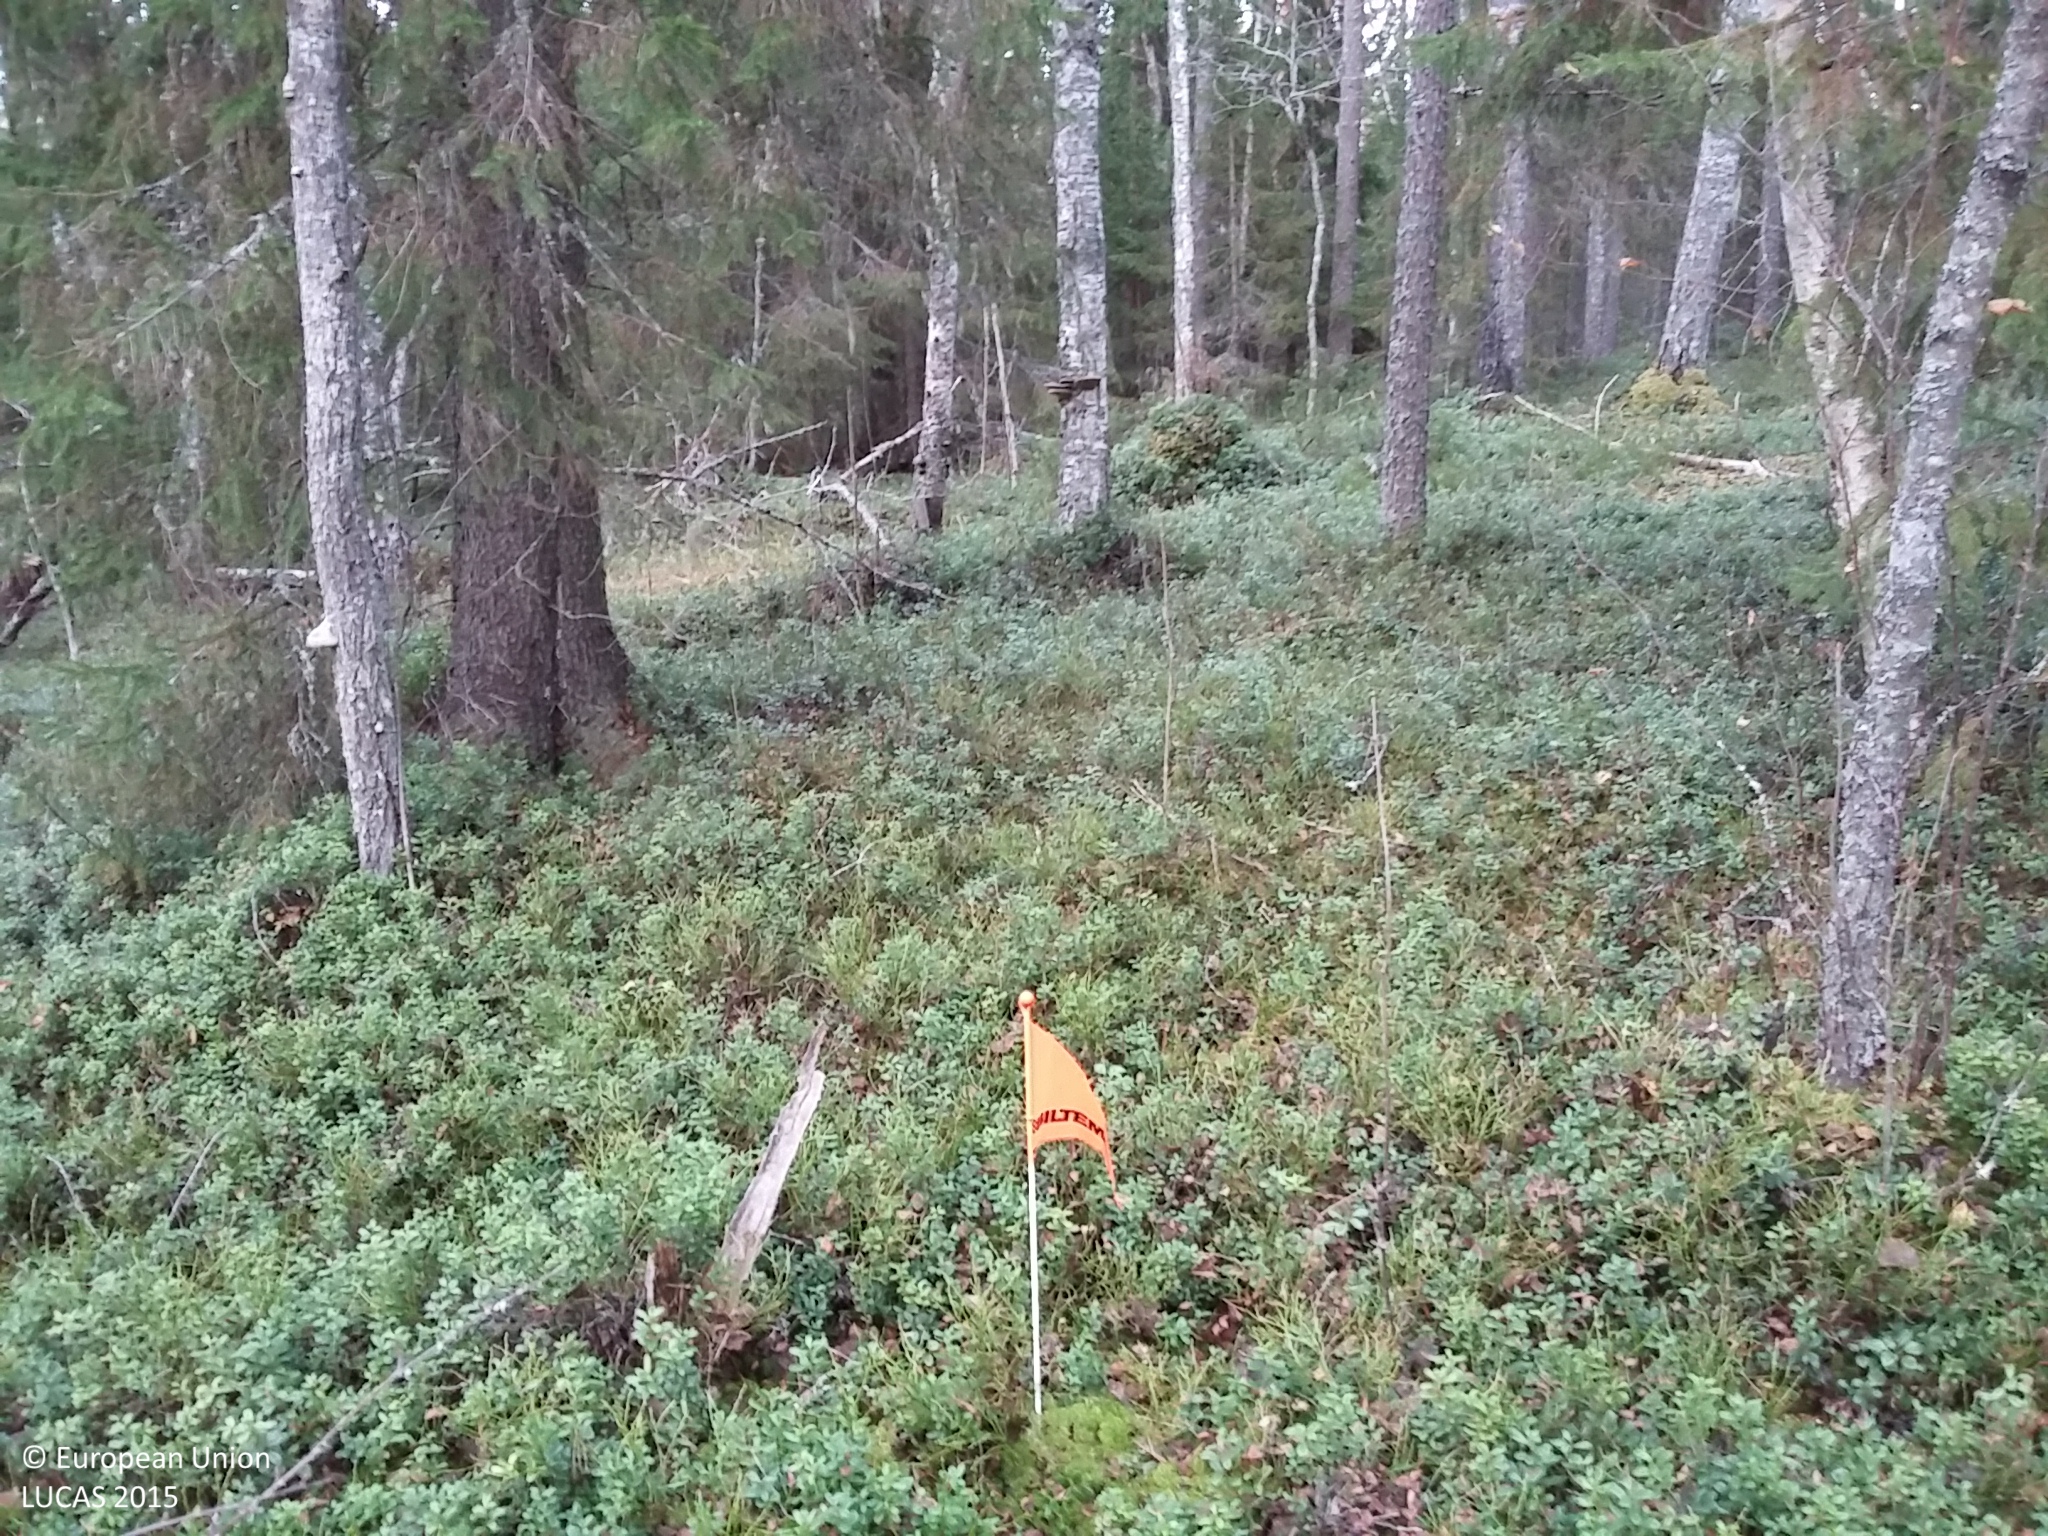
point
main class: Woodland
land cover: Spruce dominated mixed woodland
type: boreal forest
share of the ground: > 75 %
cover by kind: coniferous forest trees 45 %, broadleaved forest trees 35 %, shrubs 10 %, herbaceous plants 5 %, lichens and mosses 5 %
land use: Forestry
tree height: > 5 m
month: October
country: FI
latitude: 64.0510
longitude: 24.9749
